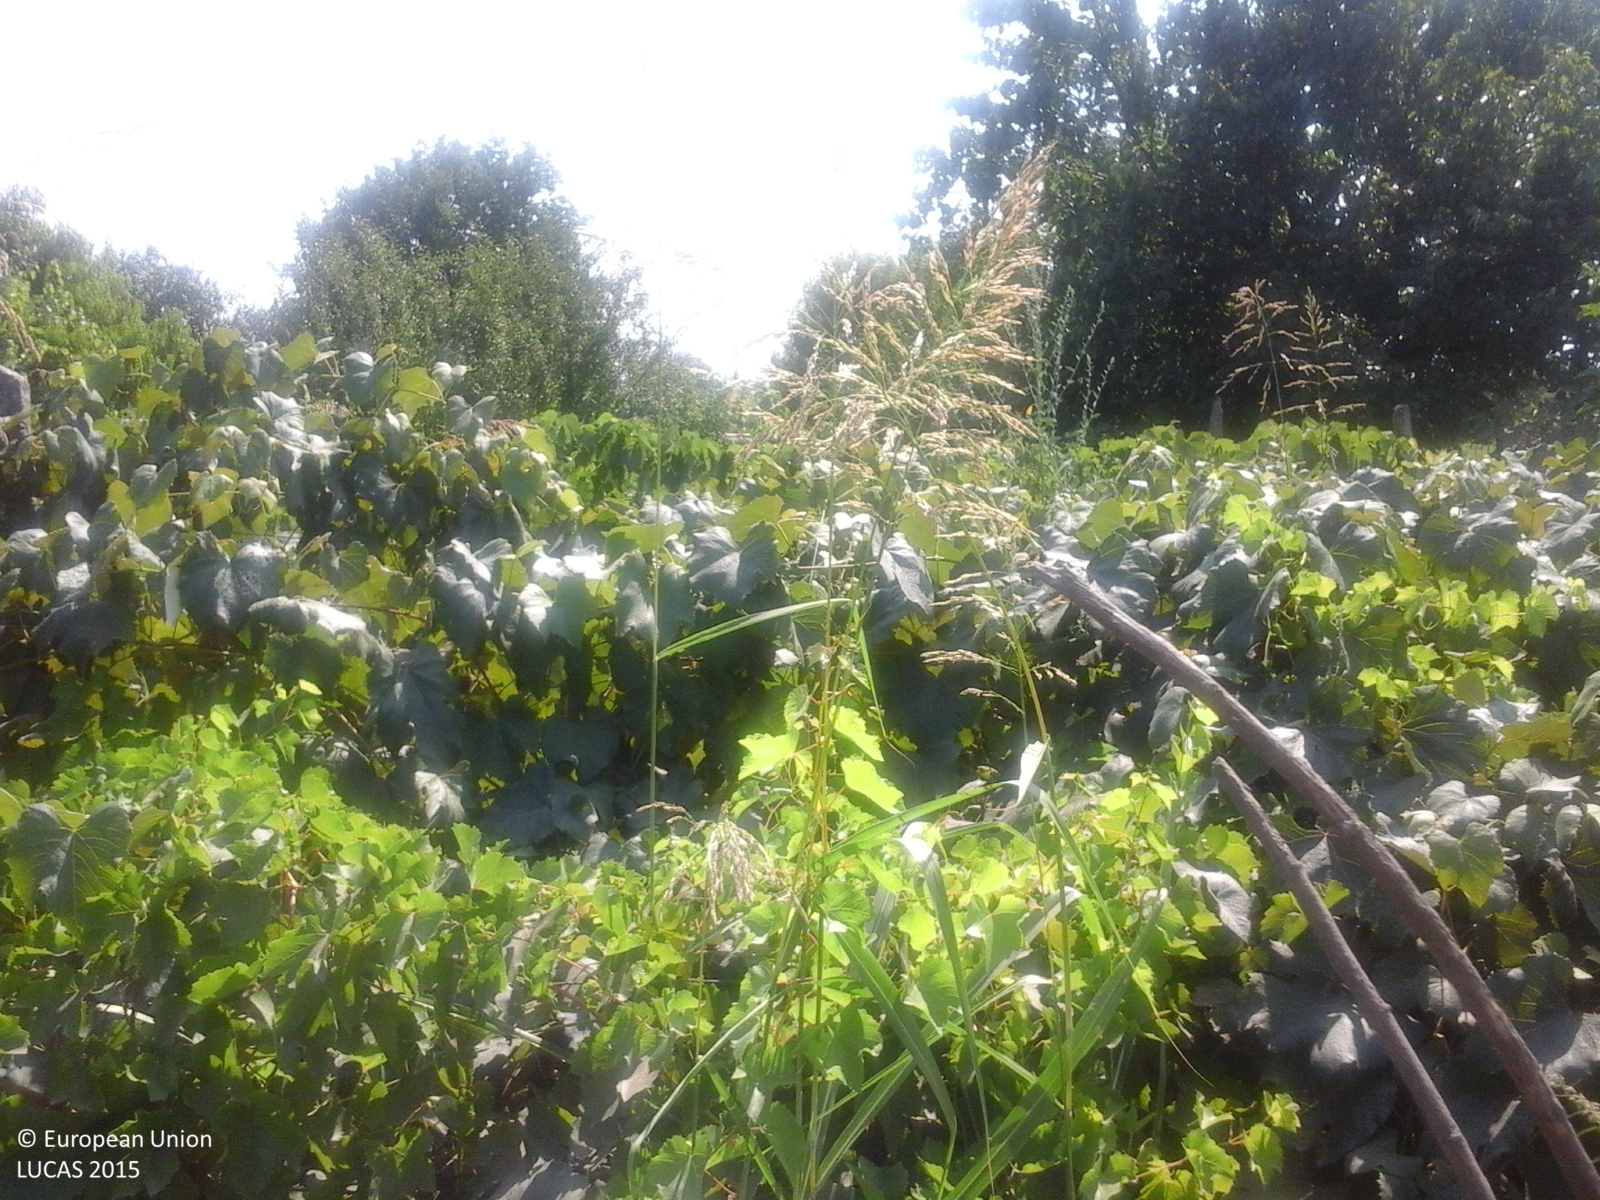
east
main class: Cropland
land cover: Vineyards
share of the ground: > 75 %
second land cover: Spontaneously vegetated surfaces
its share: 25 - 50 %
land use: Agriculture (excluding fallow land and kitchen gardens)
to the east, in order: Vineyards; Spontaneously vegetated surfaces; Artificial constructions in urban areas; Vineyards; Abandoned hedges; Lucerne; Abandoned hedges; Vineyards; Grassland without tree/shrub cover; Fences; Maize; Artificial constructions in urban areas; Arable land (only in case pi)
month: August
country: RO
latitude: 44.2141
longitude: 22.9210
